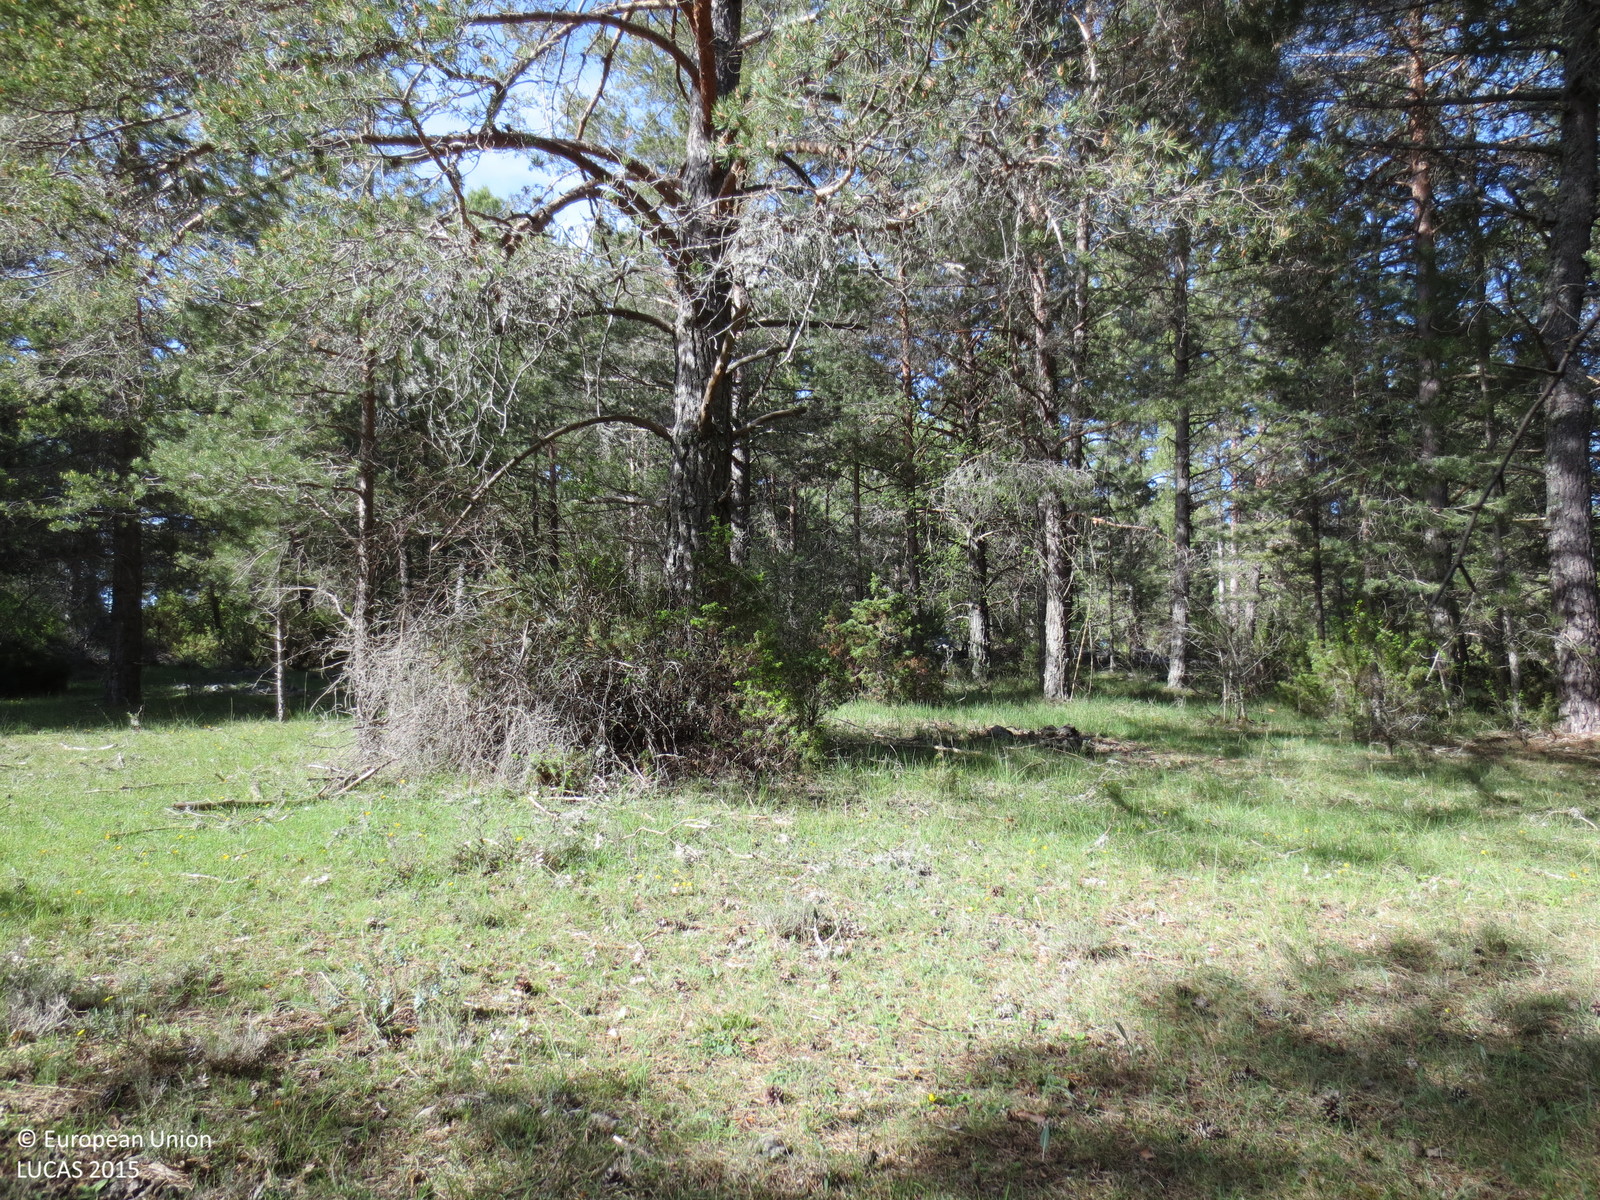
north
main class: Woodland
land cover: Pine dominated coniferous woodland
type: coniferous forest of the mediterranean region
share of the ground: 50 - 75 %
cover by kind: coniferous forest trees 60 %, shrubs 20 %, herbaceous plants 20 %
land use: Forestry
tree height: > 5 m
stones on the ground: > 50 %
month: May
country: ES
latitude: 40.4552
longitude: -2.0353
